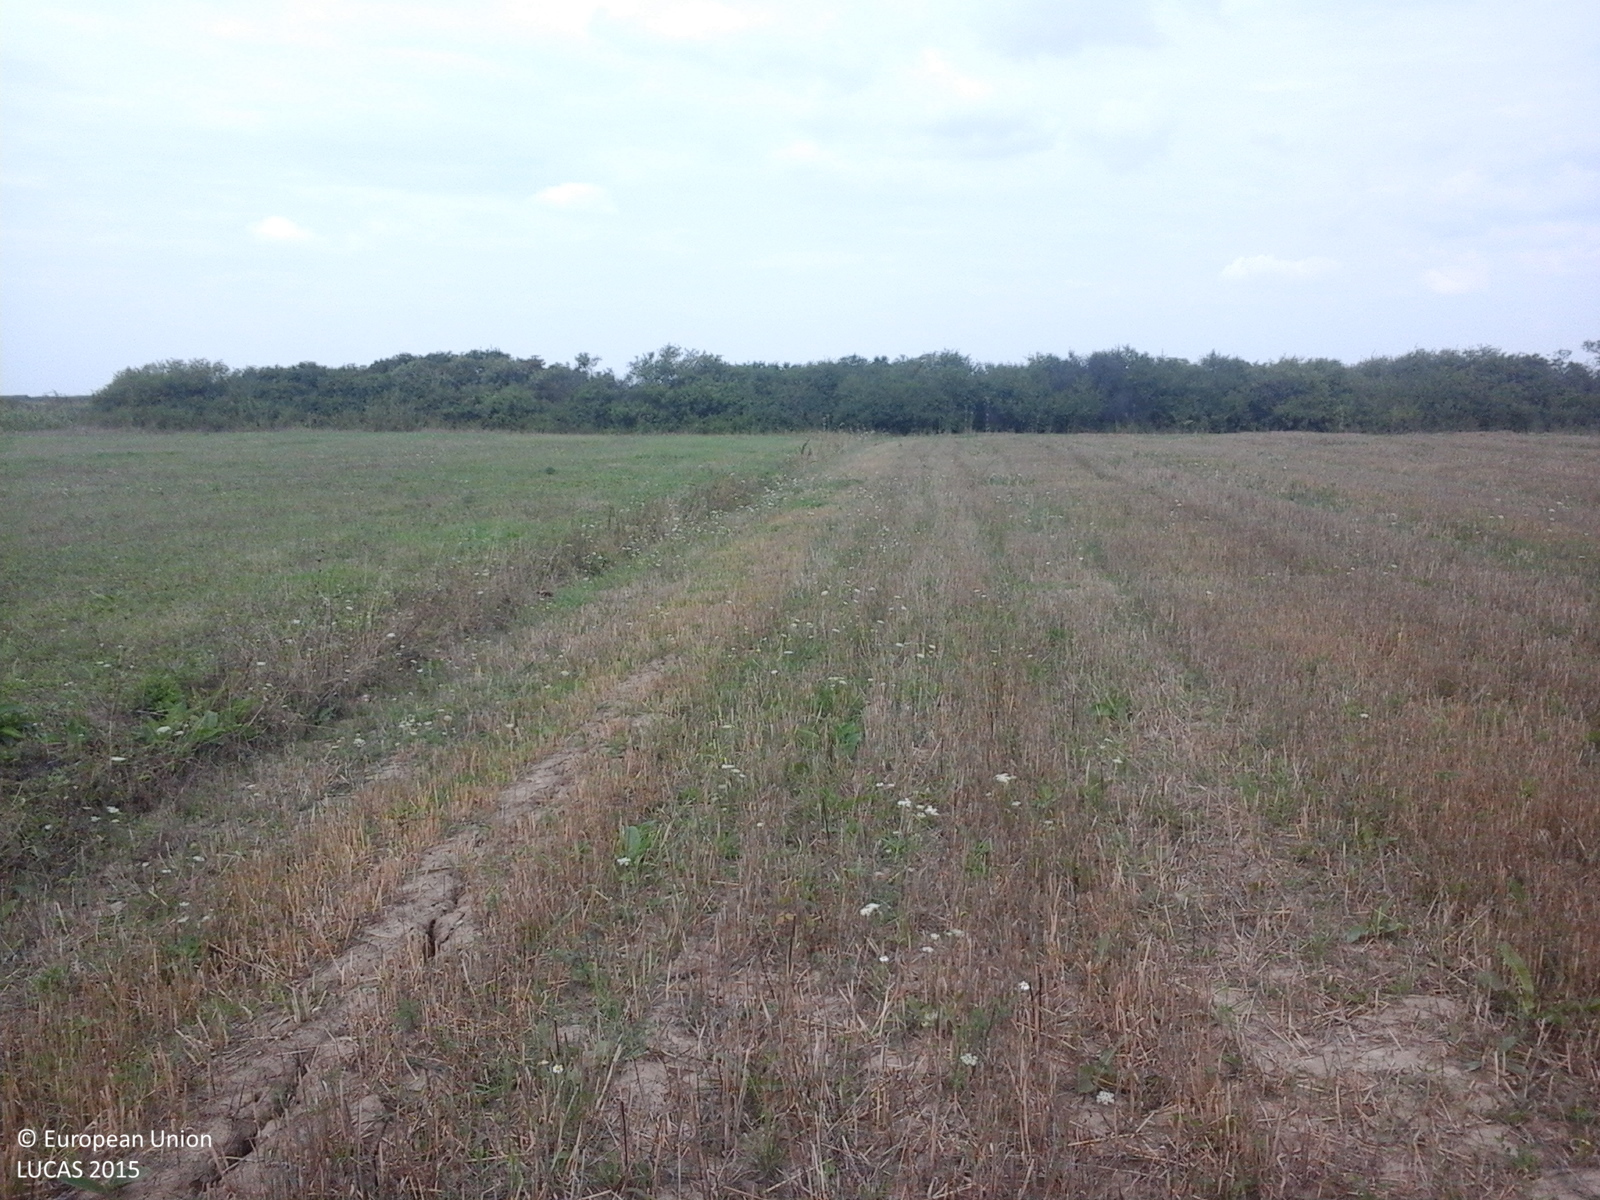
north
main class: Cropland
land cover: Common wheat
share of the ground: 50 - 75 %
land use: Agriculture (excluding fallow land and kitchen gardens)
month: August
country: RO
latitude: 46.6309
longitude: 21.7316
